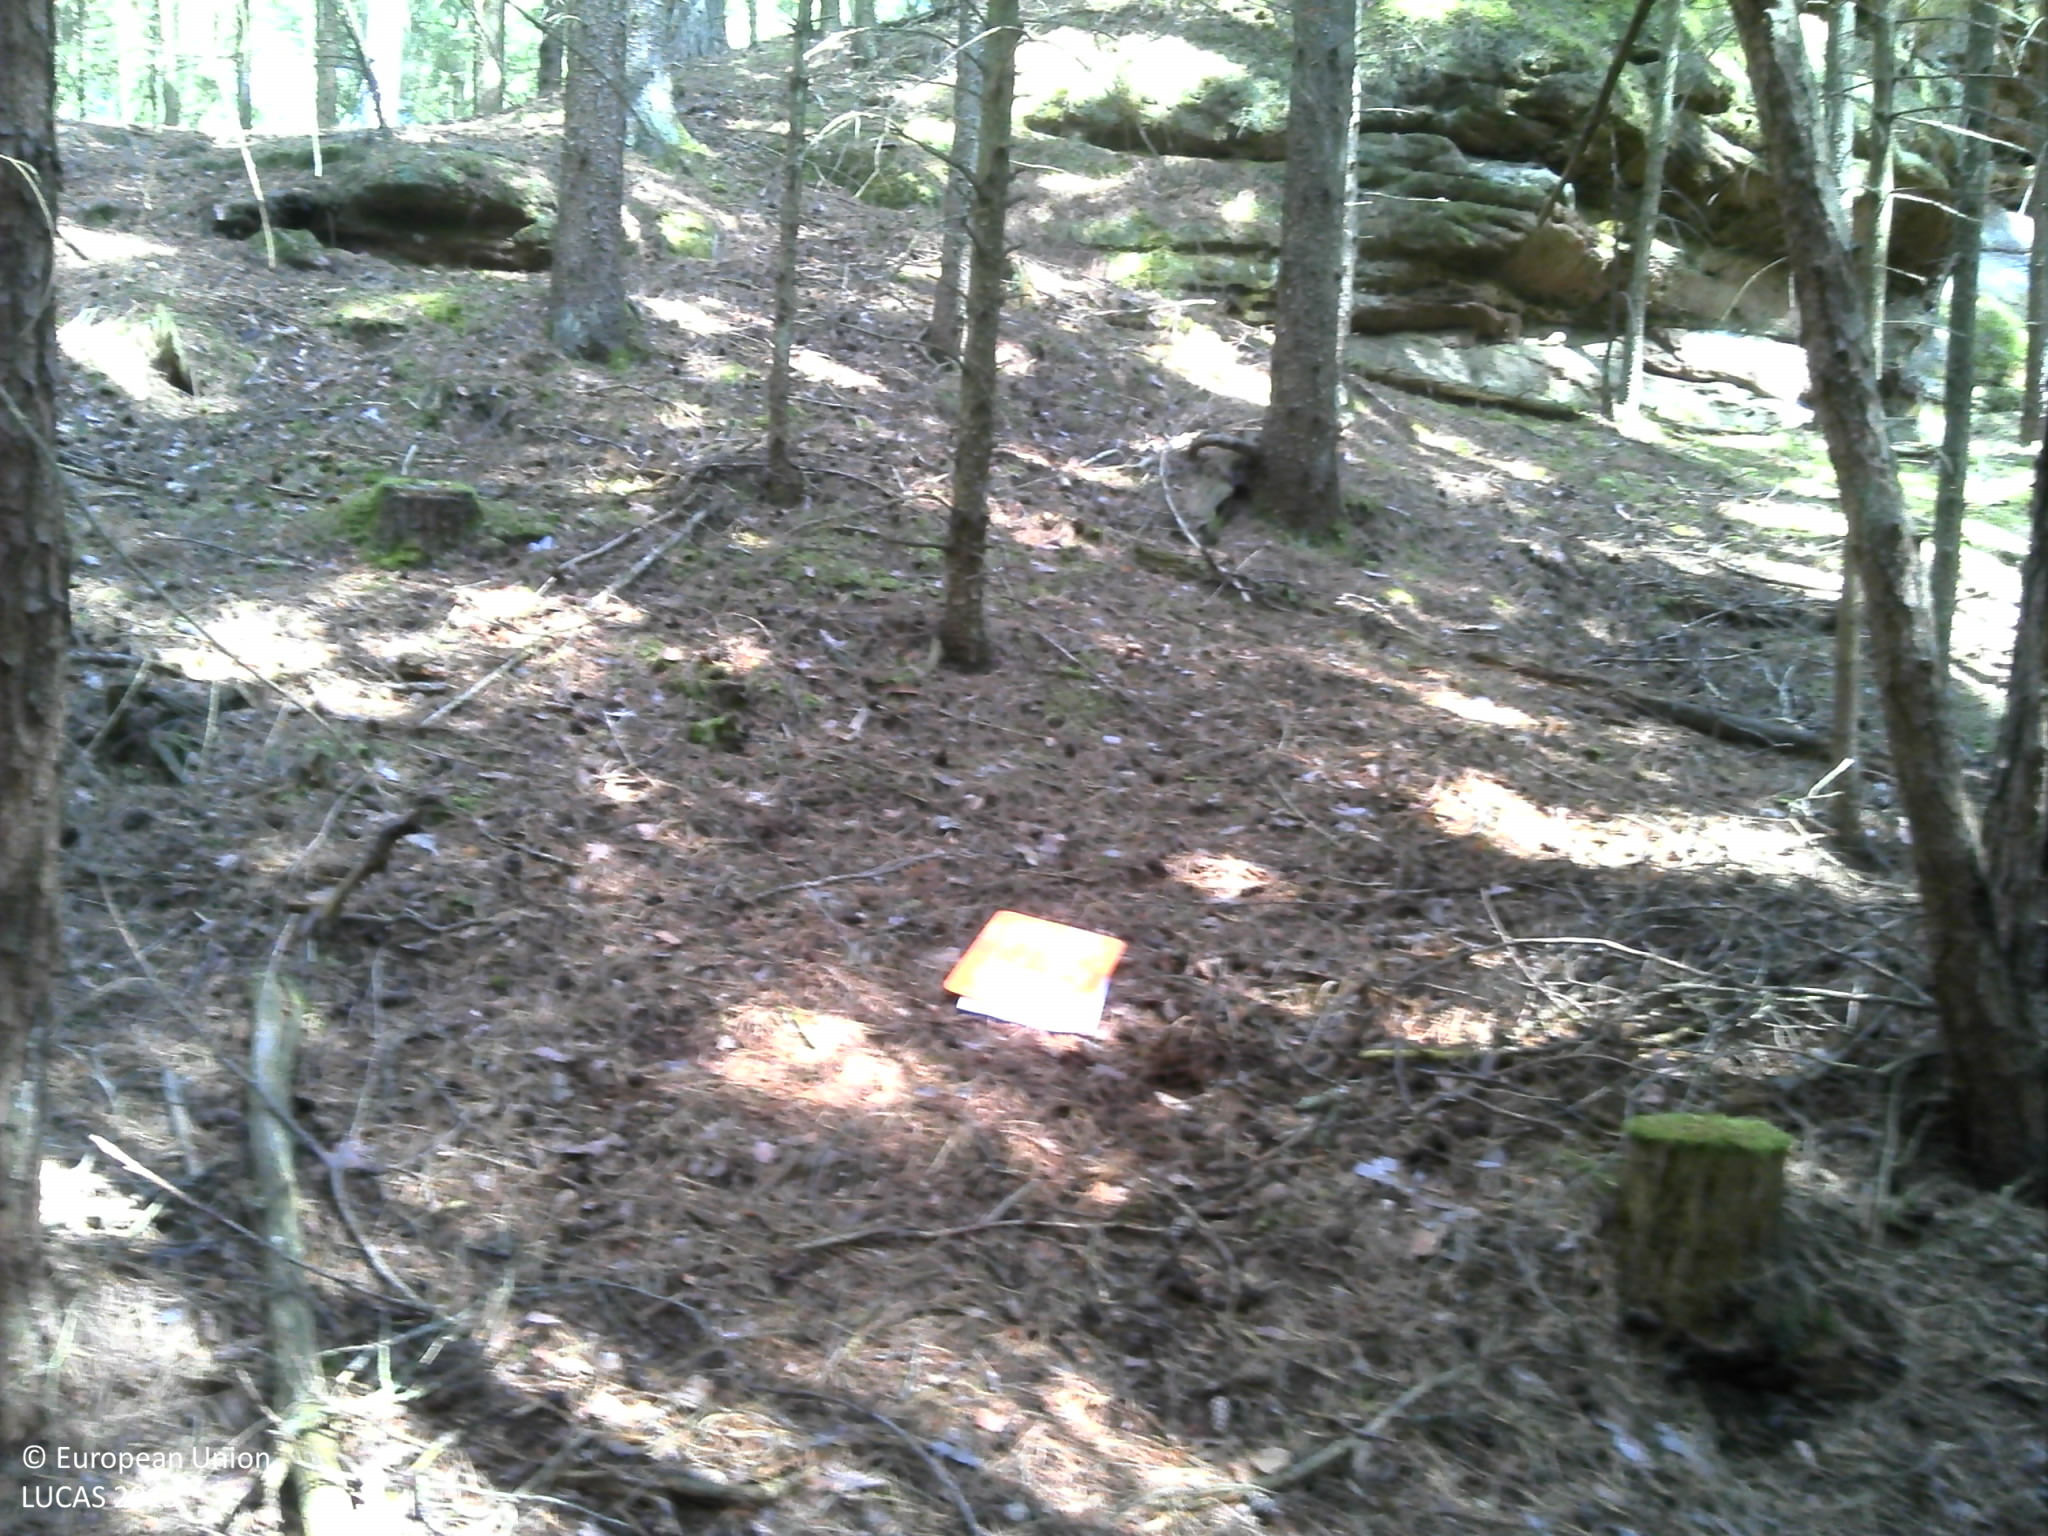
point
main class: Woodland
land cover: Other coniferous woodland
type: hemiboreal forest and nemoral coniferous forest and mixed broadleaved-coniferous forest
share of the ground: > 75 %
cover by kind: coniferous forest trees 90 %, lichens and mosses 5 %, consolidated bare surface 5 %
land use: Forestry
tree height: > 5 m
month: July
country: FR
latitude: 49.0256
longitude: 7.6073
